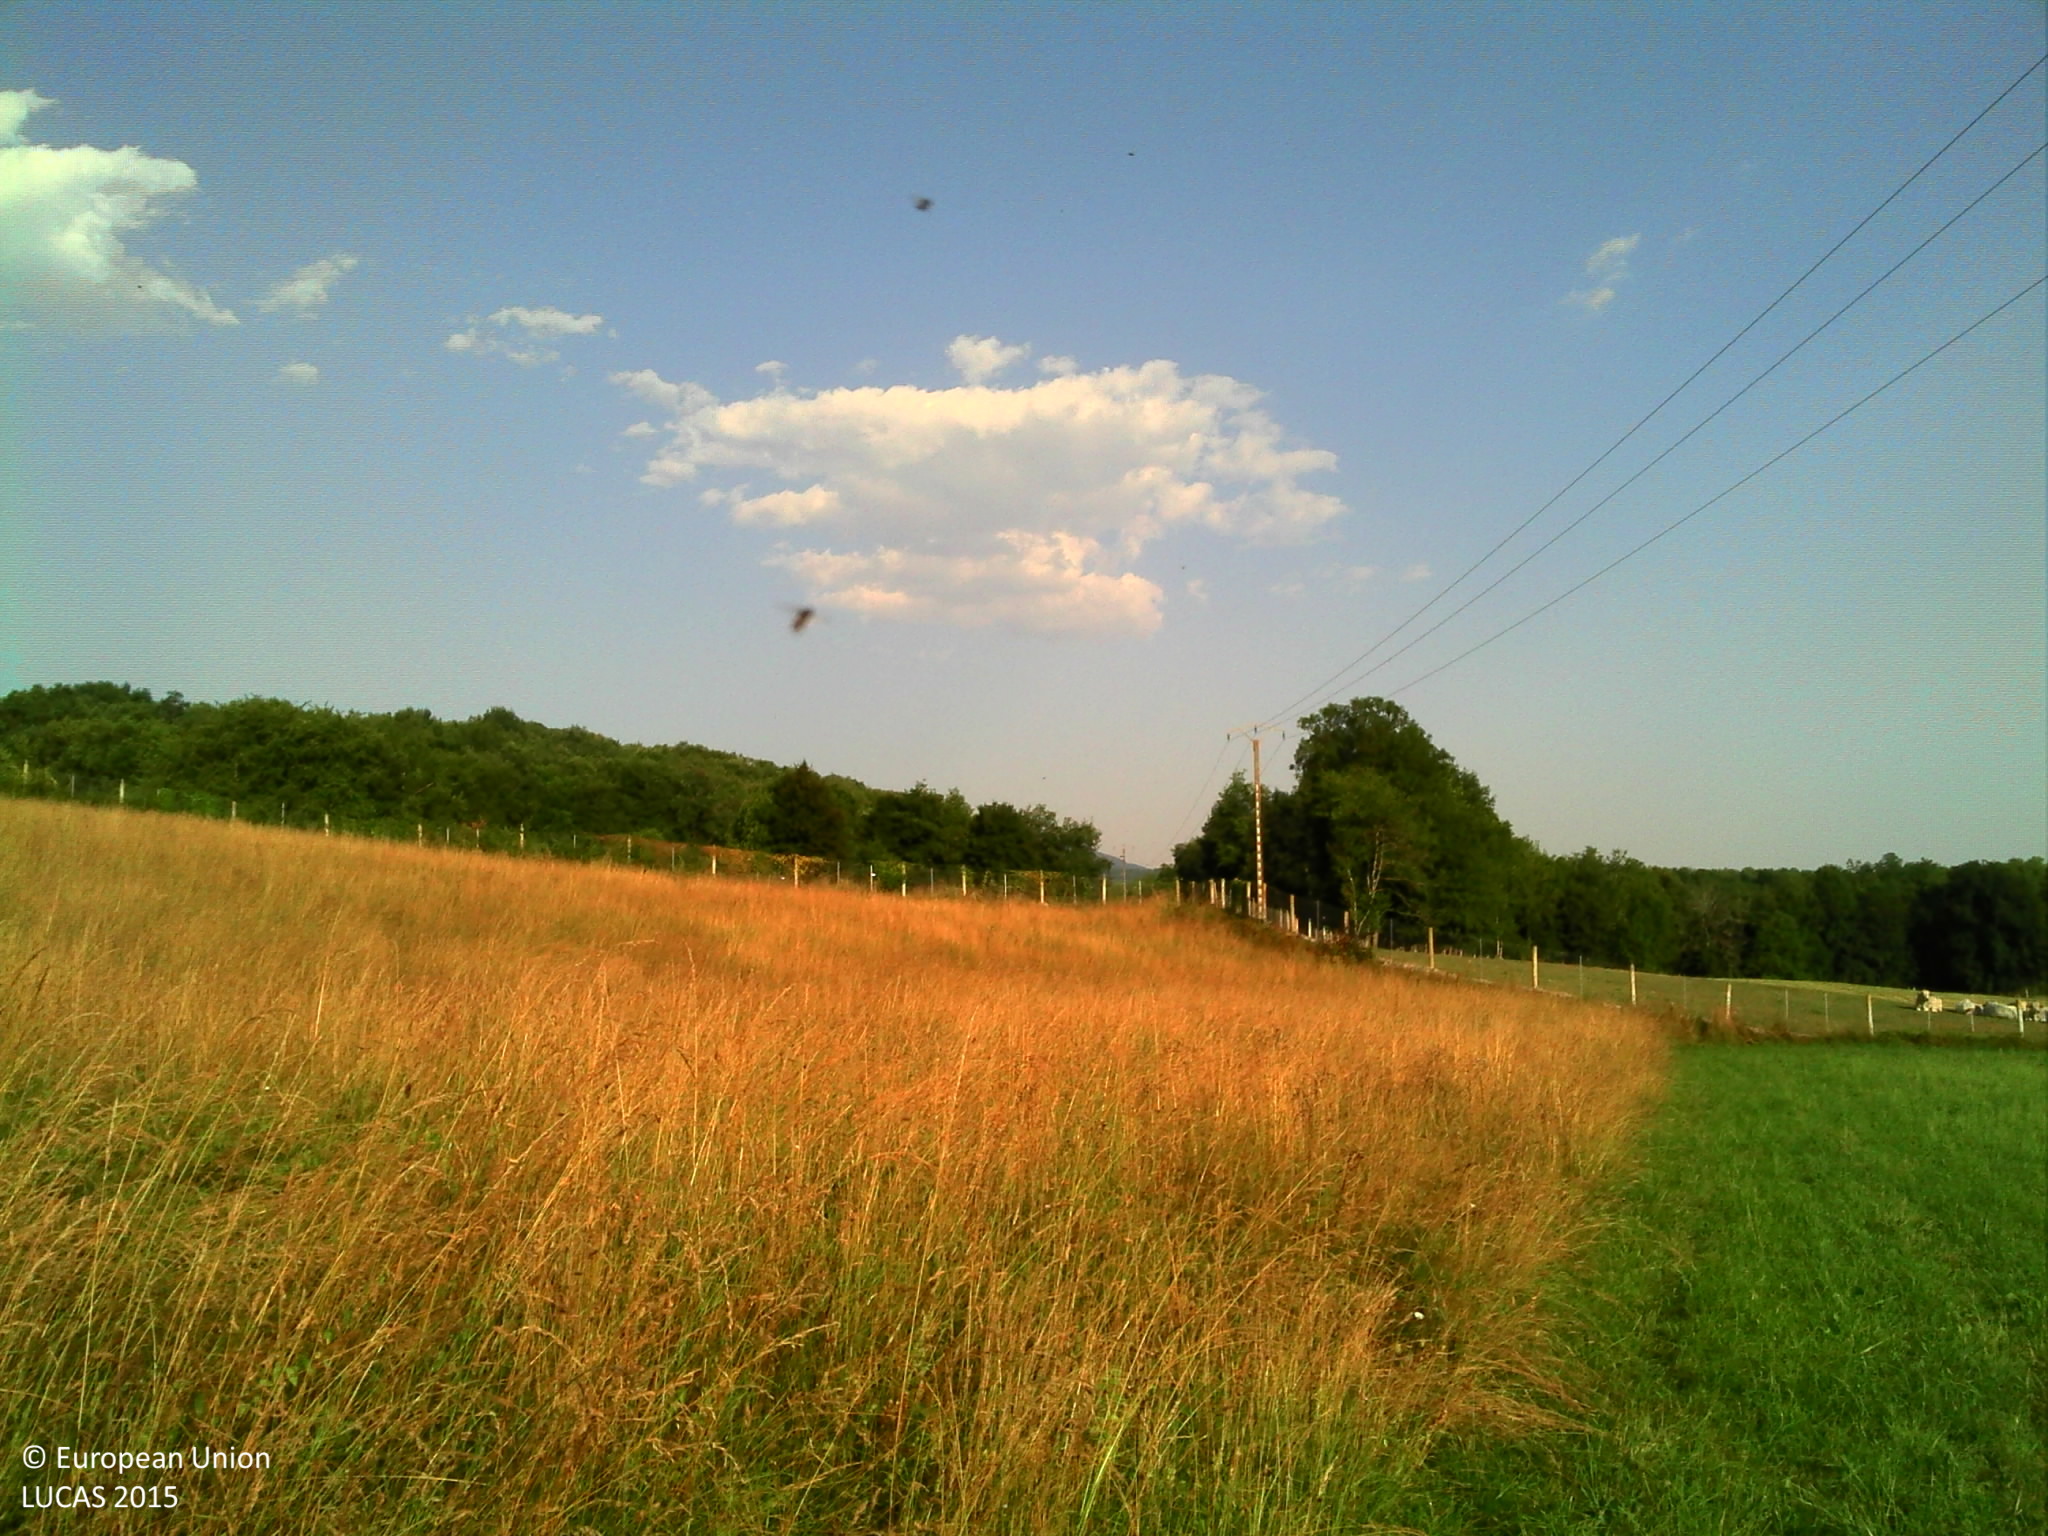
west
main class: Grassland
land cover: Grassland without tree/shrub cover
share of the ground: > 75 %
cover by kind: herbaceous plants 100 %
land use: Agriculture (excluding fallow land and kitchen gardens)
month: July
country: FR
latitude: 42.9731
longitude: 1.1399
